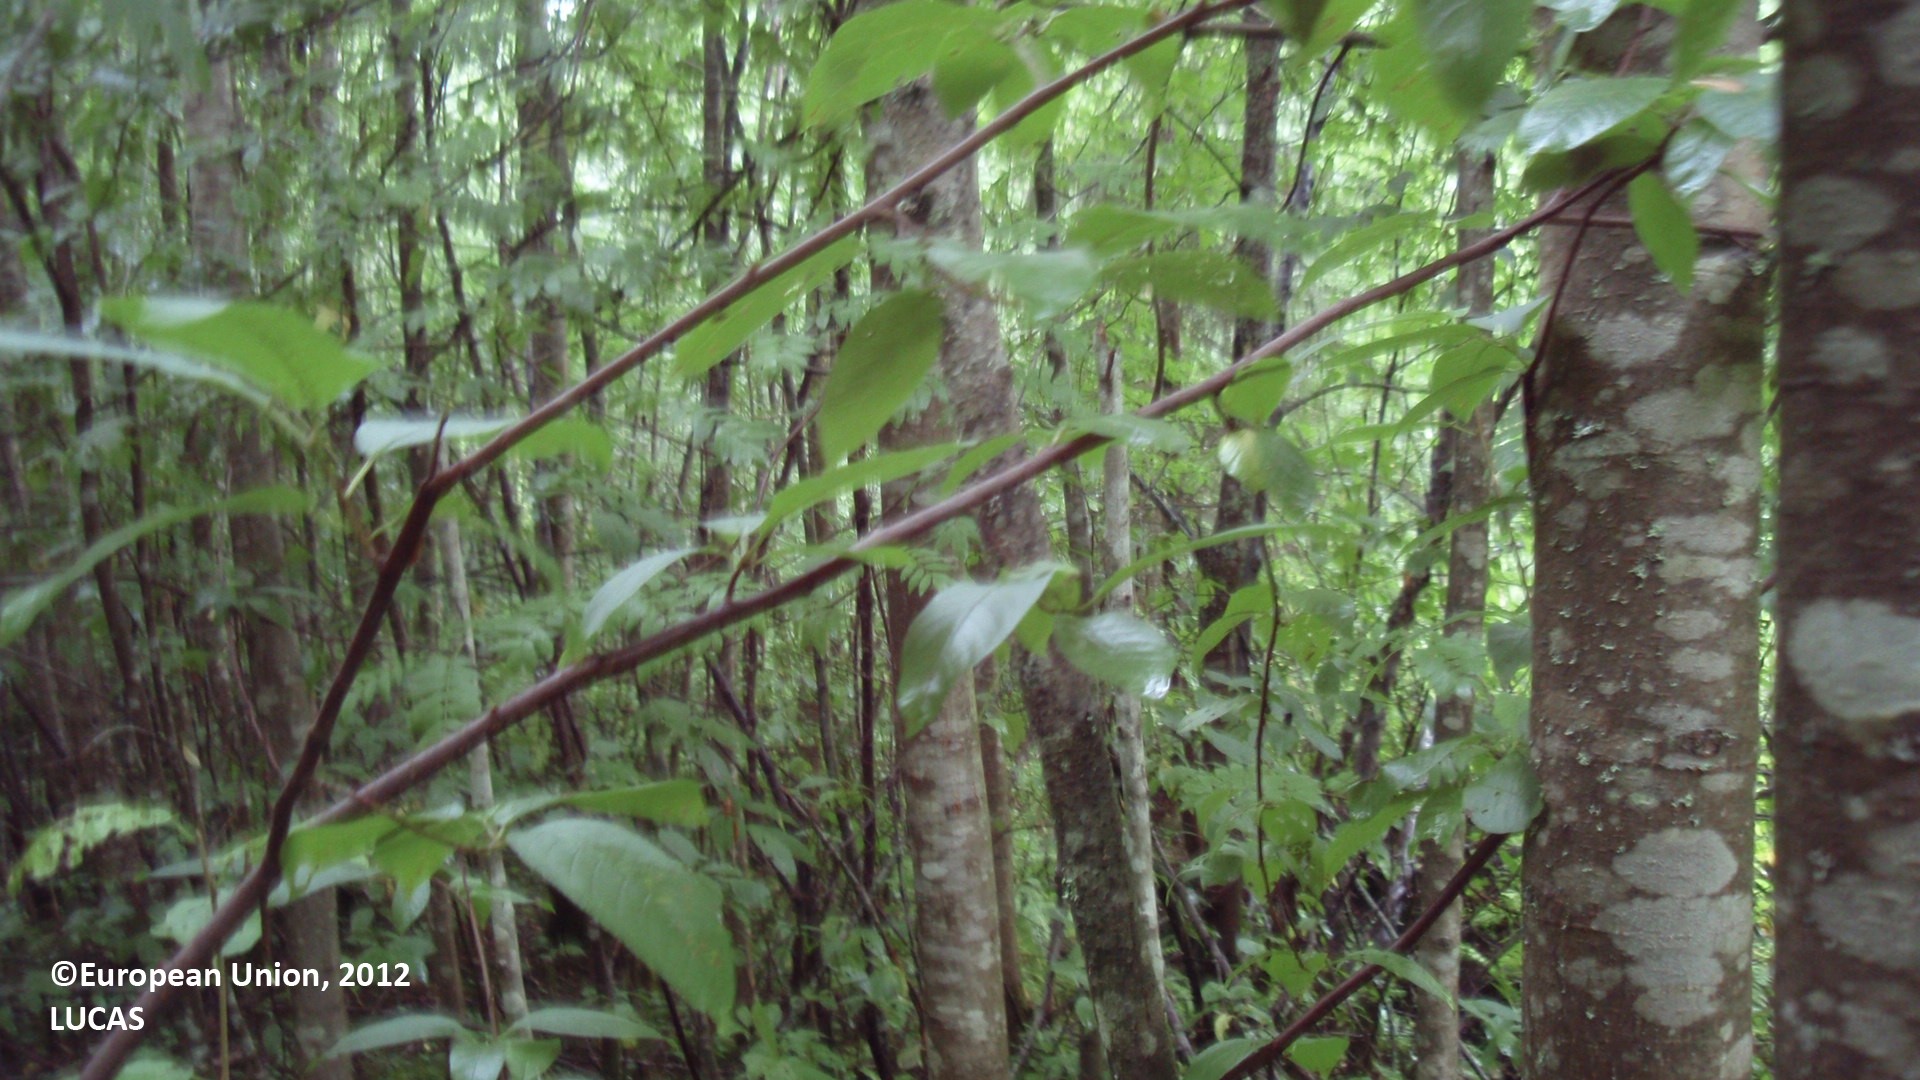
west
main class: Woodland
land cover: Broadleaved woodland
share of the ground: > 75 %
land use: Forestry
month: July
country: FI
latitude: 61.5460
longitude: 27.2723
